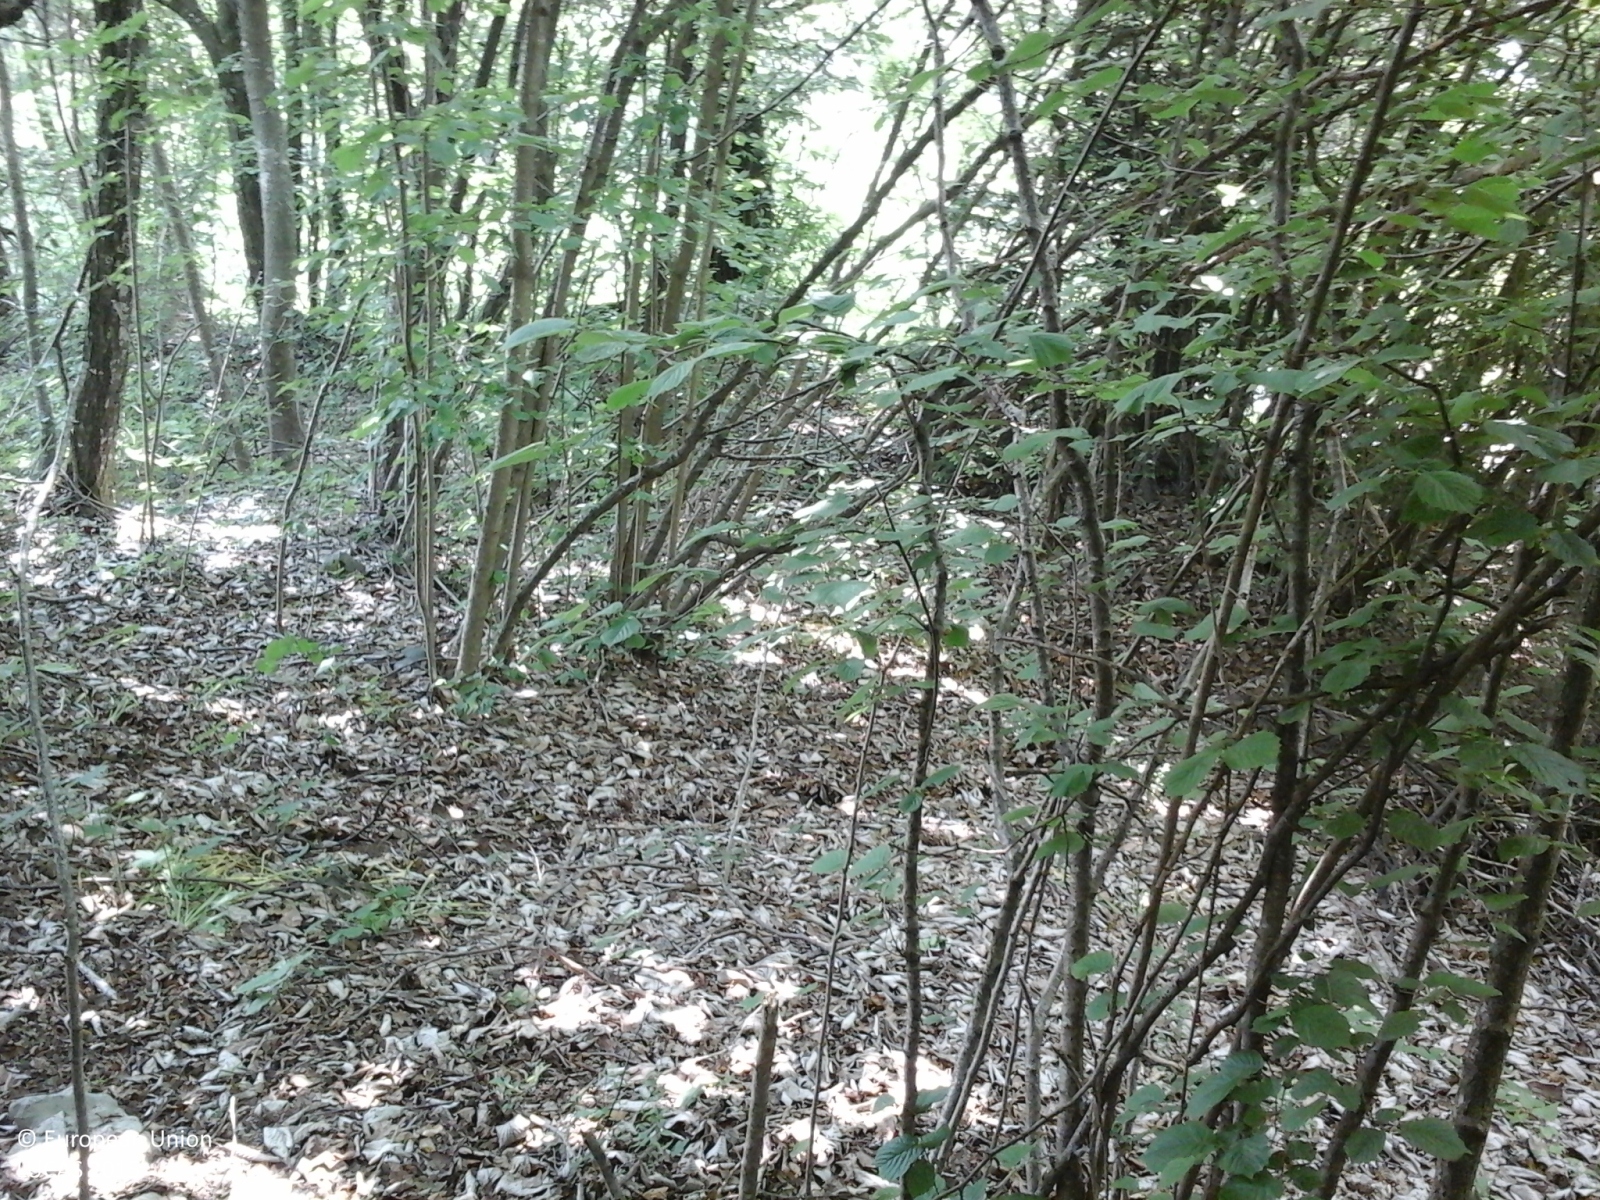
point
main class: Woodland
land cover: Broadleaved woodland
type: thermophilous deciduous forest
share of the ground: > 75 %
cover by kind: broadleaved forest trees 100 %
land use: Forestry
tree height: > 5 m
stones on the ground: 10 - 25 %
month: June
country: IT
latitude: 45.7195
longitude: 10.5002
